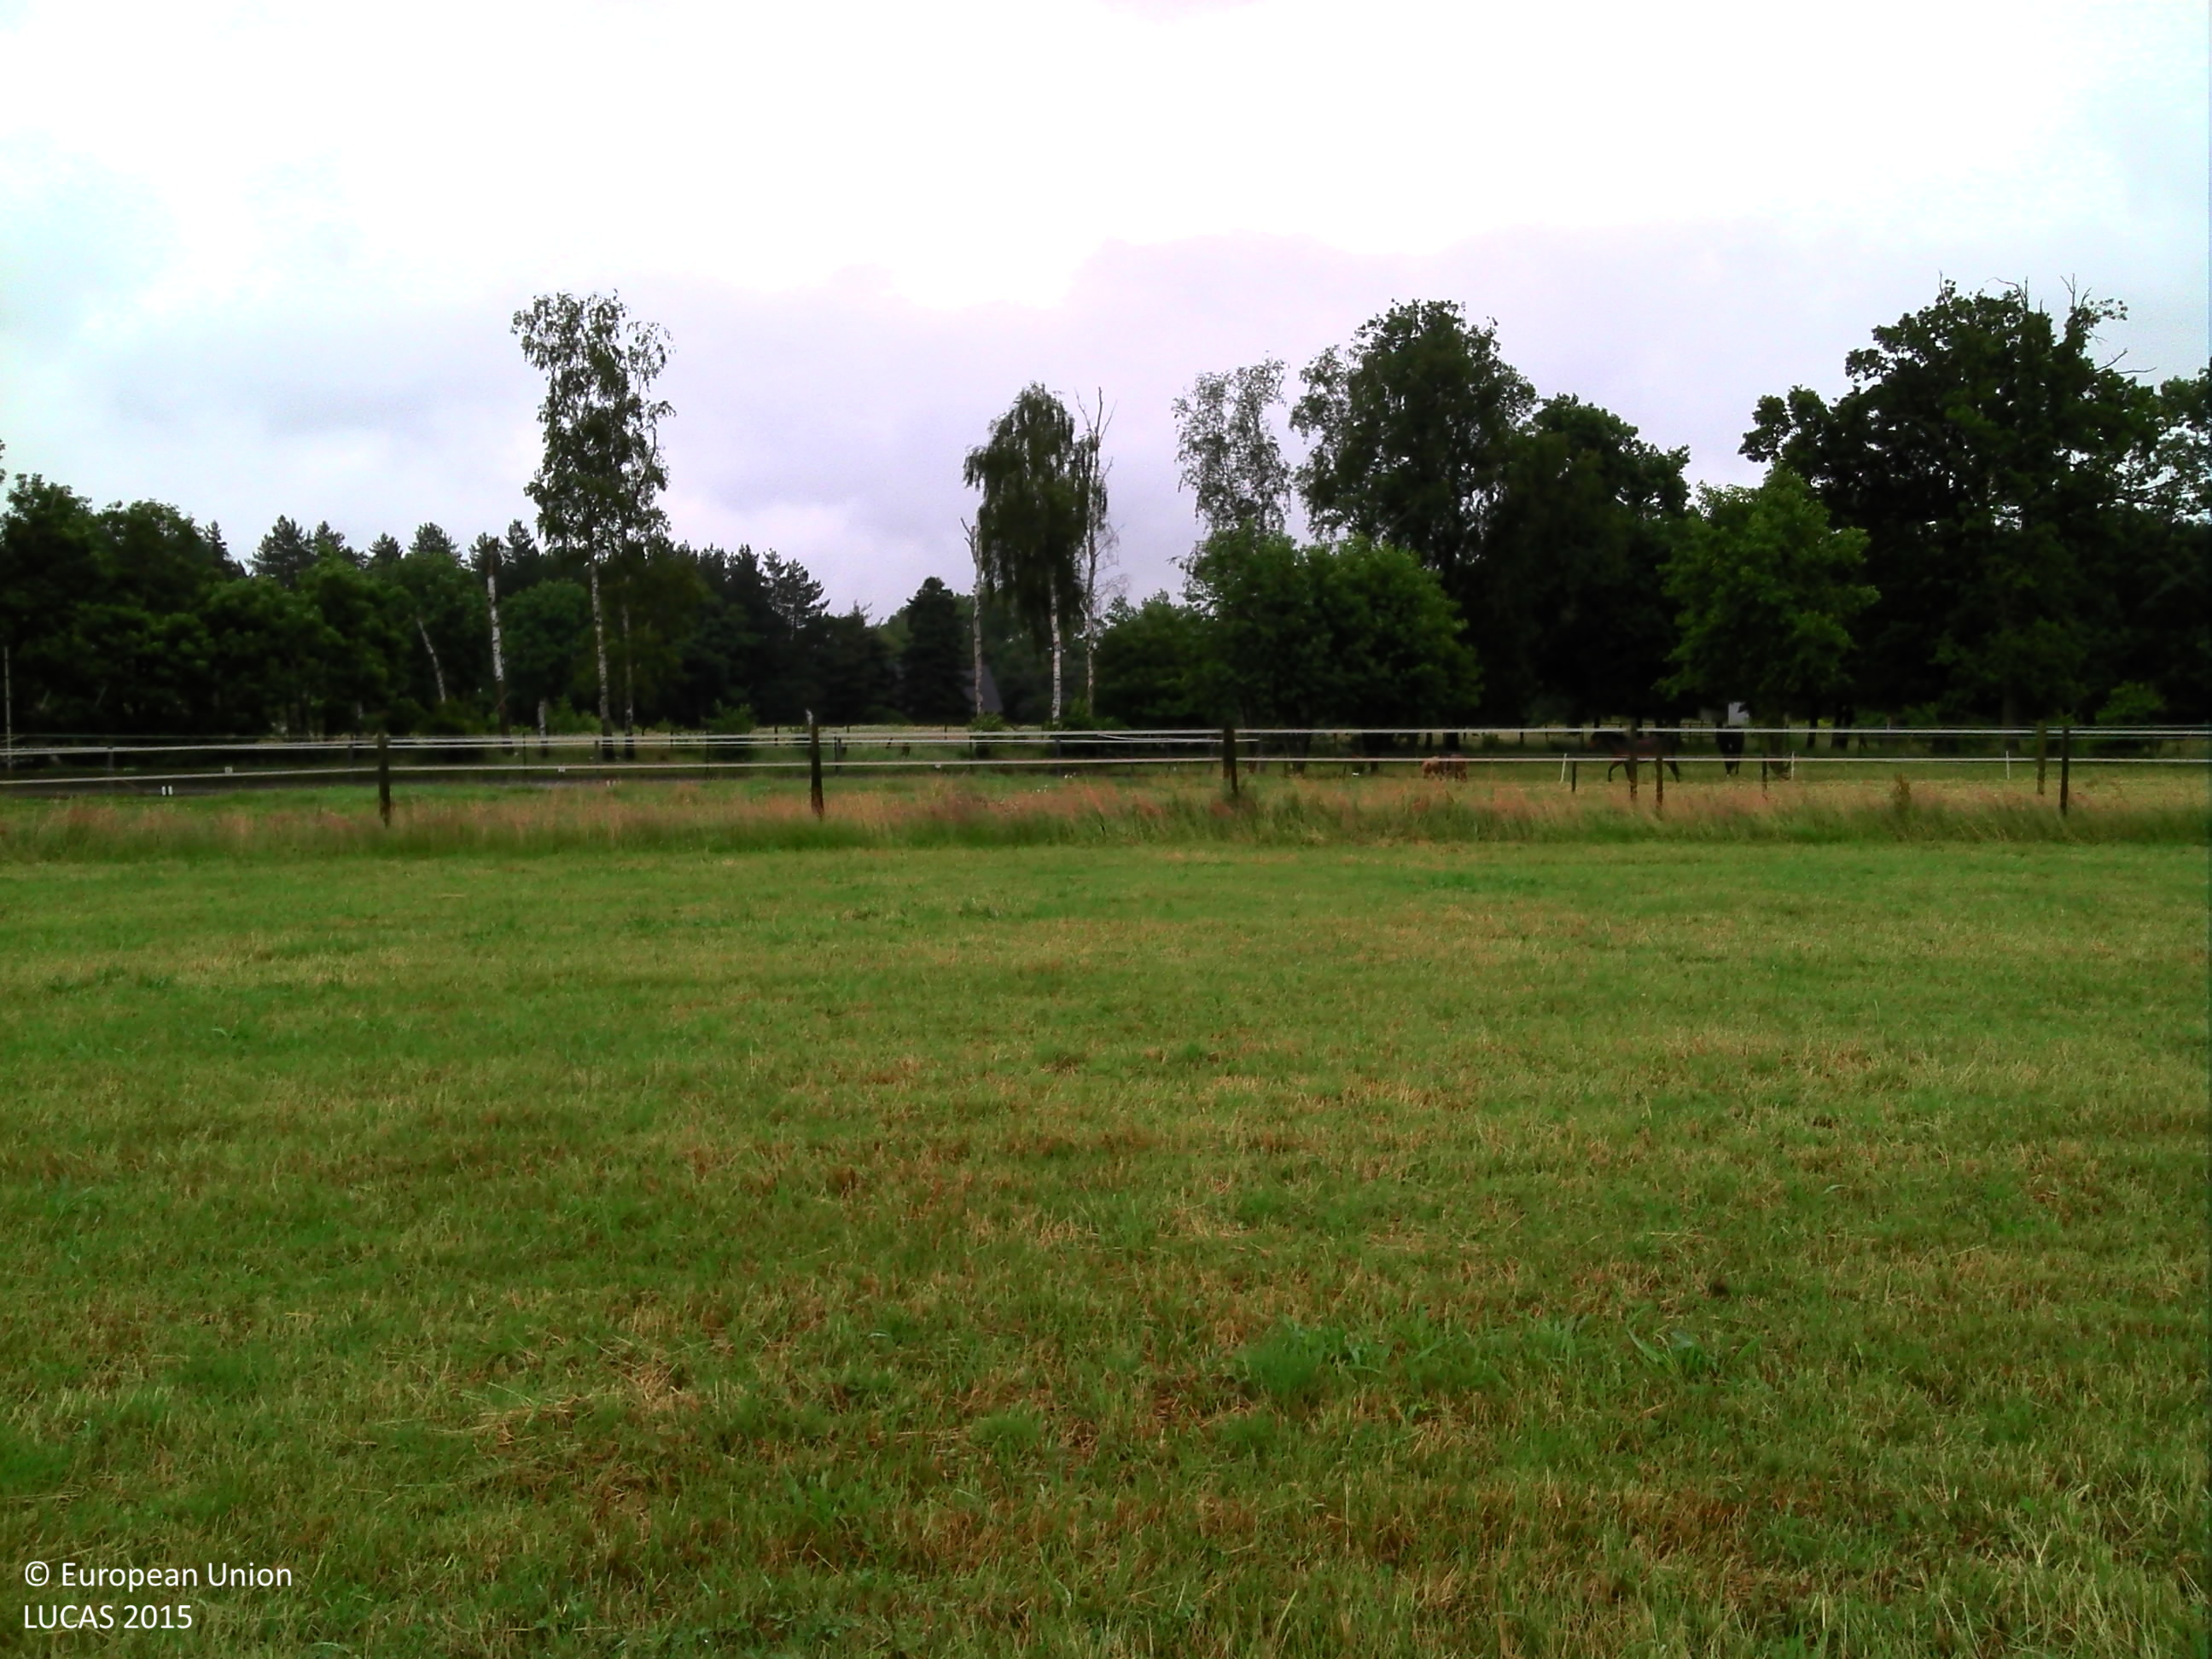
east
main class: Grassland
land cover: Grassland without tree/shrub cover
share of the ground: > 75 %
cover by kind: herbaceous plants 100 %
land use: Agriculture (excluding fallow land and kitchen gardens)
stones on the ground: < 10 %
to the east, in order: Grassland without tree/shrub cover; Fences; Grass margins; Fences; Grassland without tree/shrub cover; Fences; Other bare soil; Fences; Lines of trees; Fences; Grassland with sparse tree/shrub cover; Fences; Grassland without tree/shrub cover; Fences; Ditches and canals; Electric lines; Grass margins; Paved roads, cycling and walking lanes; Artificial constructions in urban areas
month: June
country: BE
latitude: 51.0937
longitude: 5.2429
